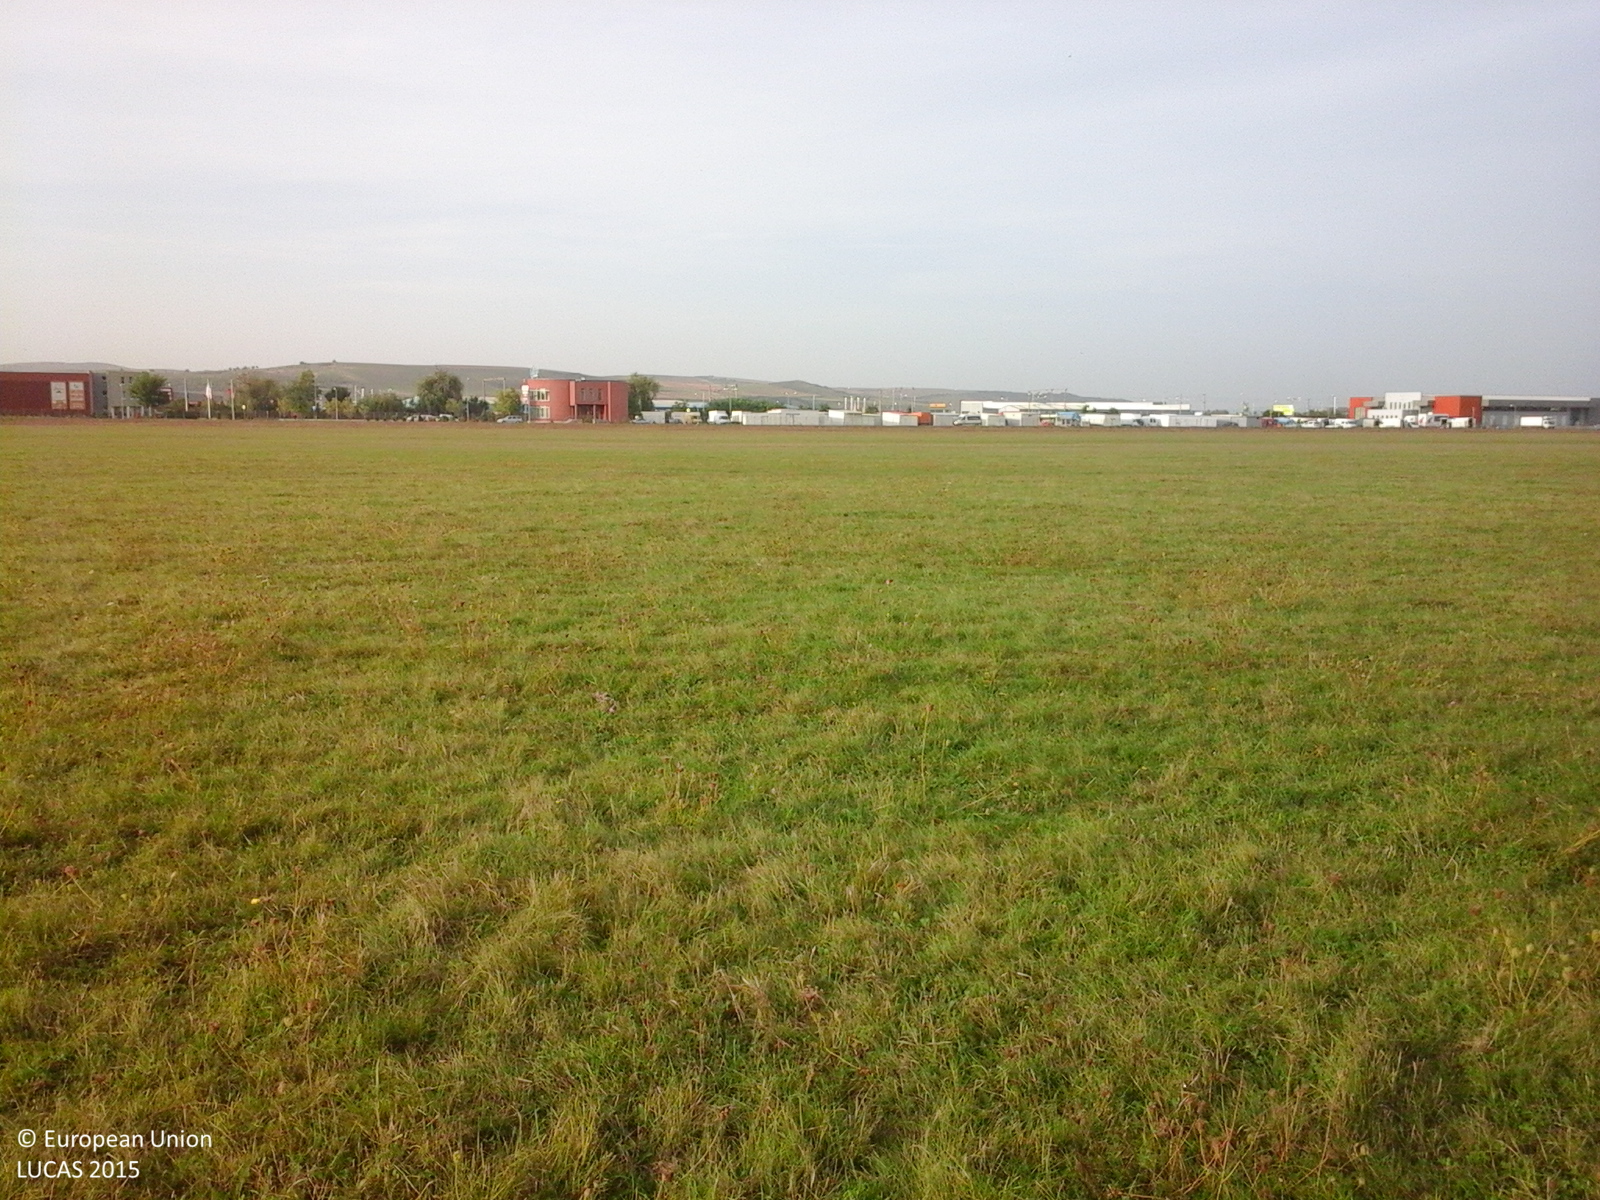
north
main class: Grassland
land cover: Grassland without tree/shrub cover
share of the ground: > 75 %
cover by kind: herbaceous plants 100 %
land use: Agriculture (excluding fallow land and kitchen gardens)
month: September
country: RO
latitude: 46.7782
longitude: 23.7073
